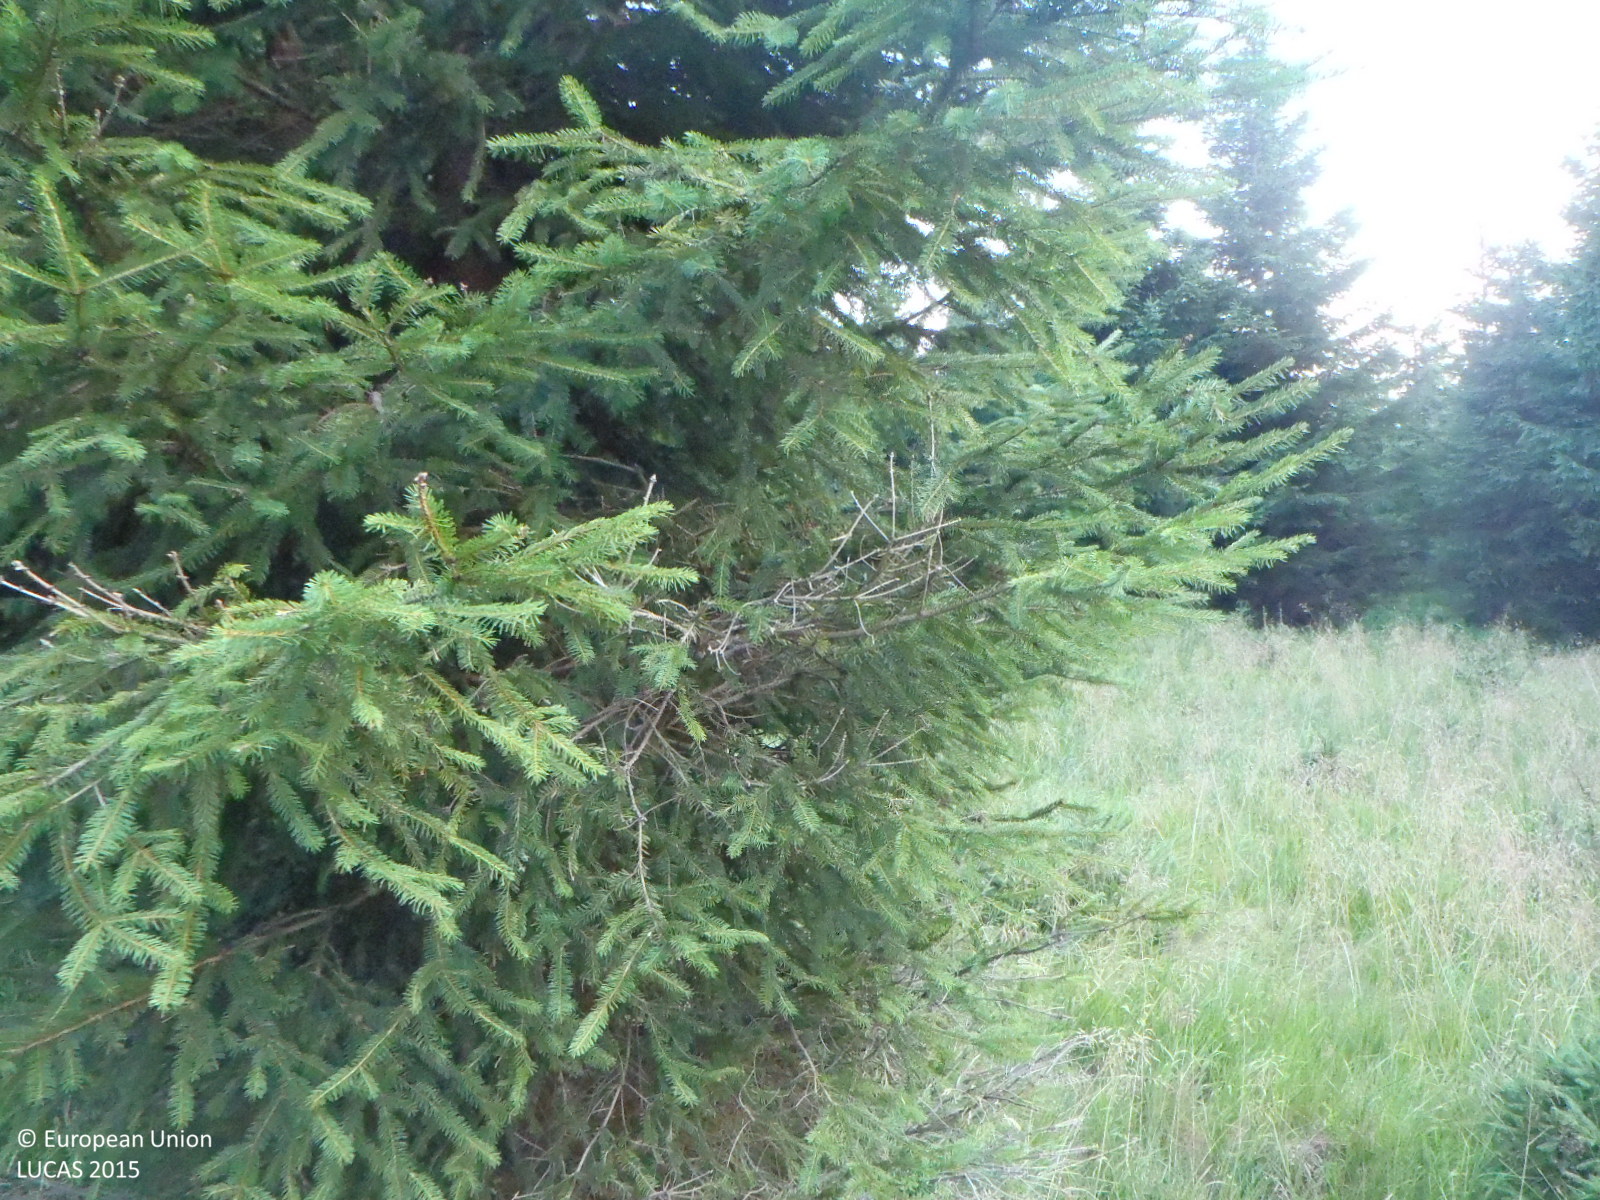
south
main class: Woodland
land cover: Spruce dominated coniferous woodland
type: hemiboreal forest and nemoral coniferous forest and mixed broadleaved-coniferous forest
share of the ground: > 75 %
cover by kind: coniferous forest trees 80 %, herbaceous plants 15 %, shrubs 5 %
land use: Forestry
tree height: > 5 m
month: August
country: CZ
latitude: 50.8205
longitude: 15.2414
